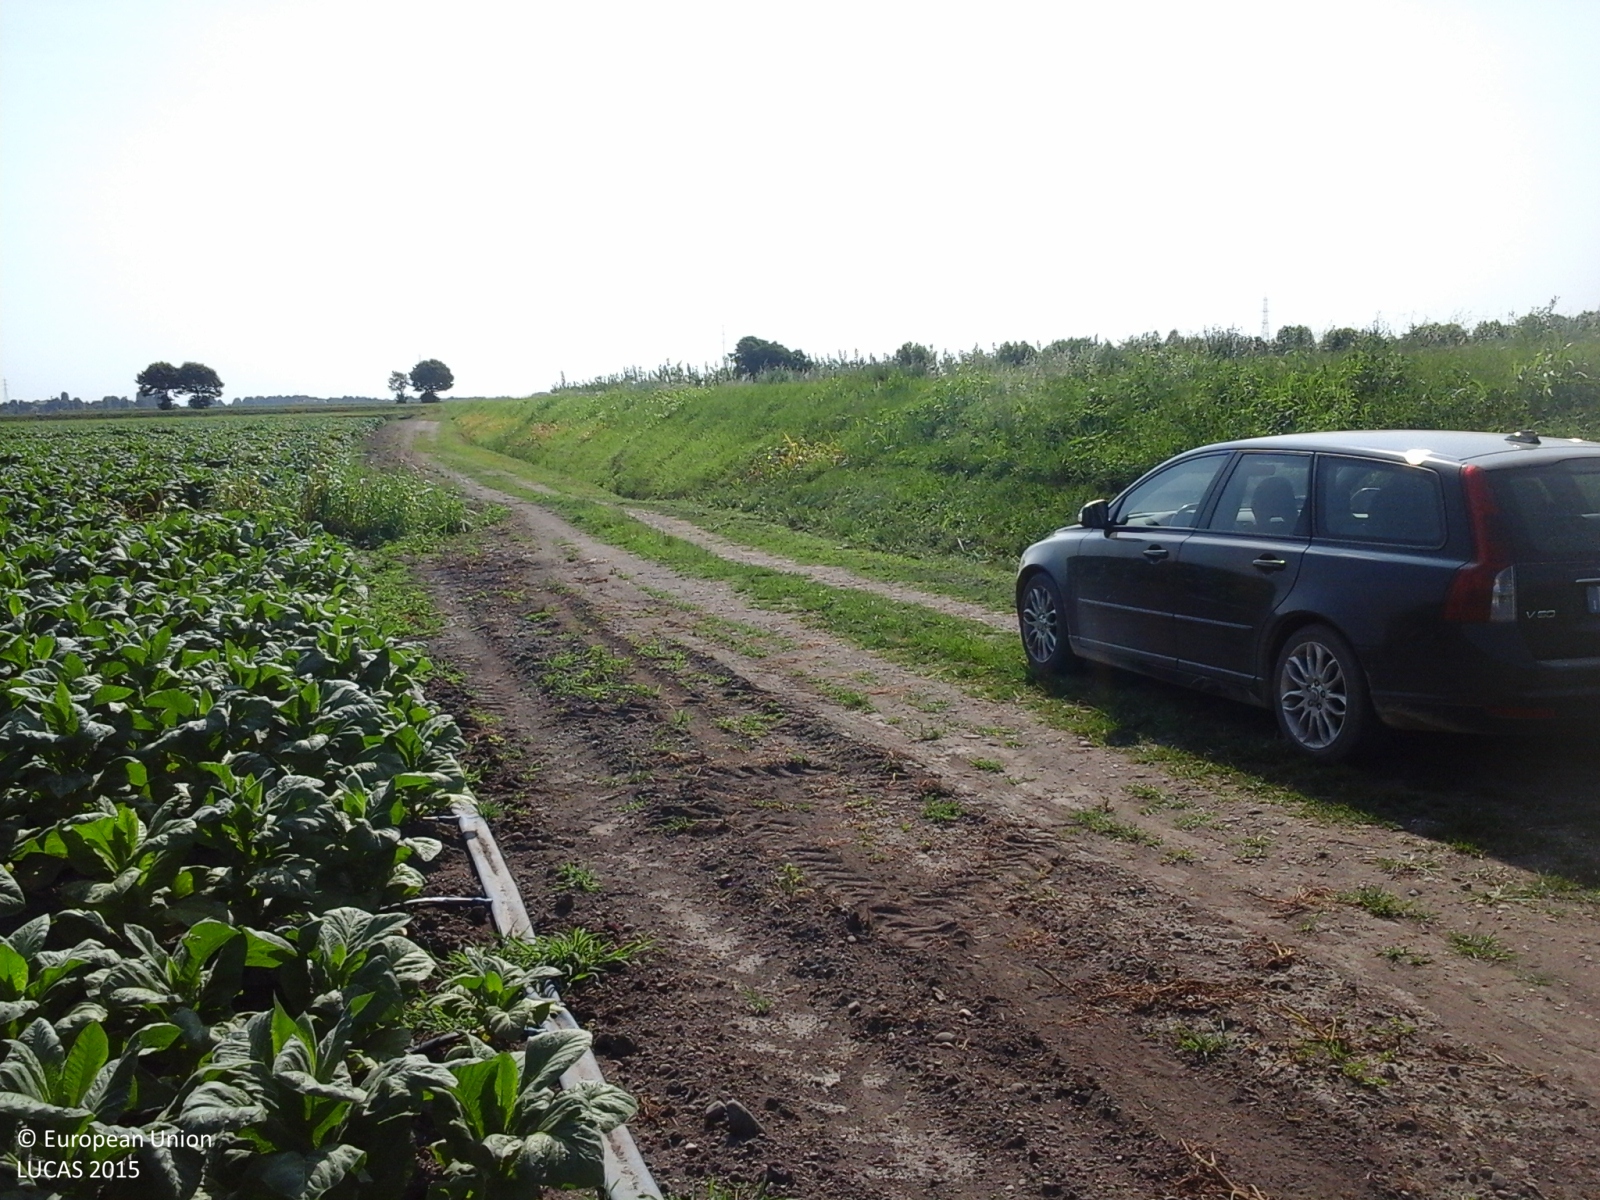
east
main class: Cropland
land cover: Tobacco
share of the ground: > 75 %
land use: Agriculture (excluding fallow land and kitchen gardens)
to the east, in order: Tobacco; Tracks; Ditches and canals; Grassland without tree/shrub cover; Tracks; Inland fresh running water; Tracks; Grassland without tree/shrub cover; Broadleaved woodland
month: July
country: IT
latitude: 45.3191
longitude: 11.0315
